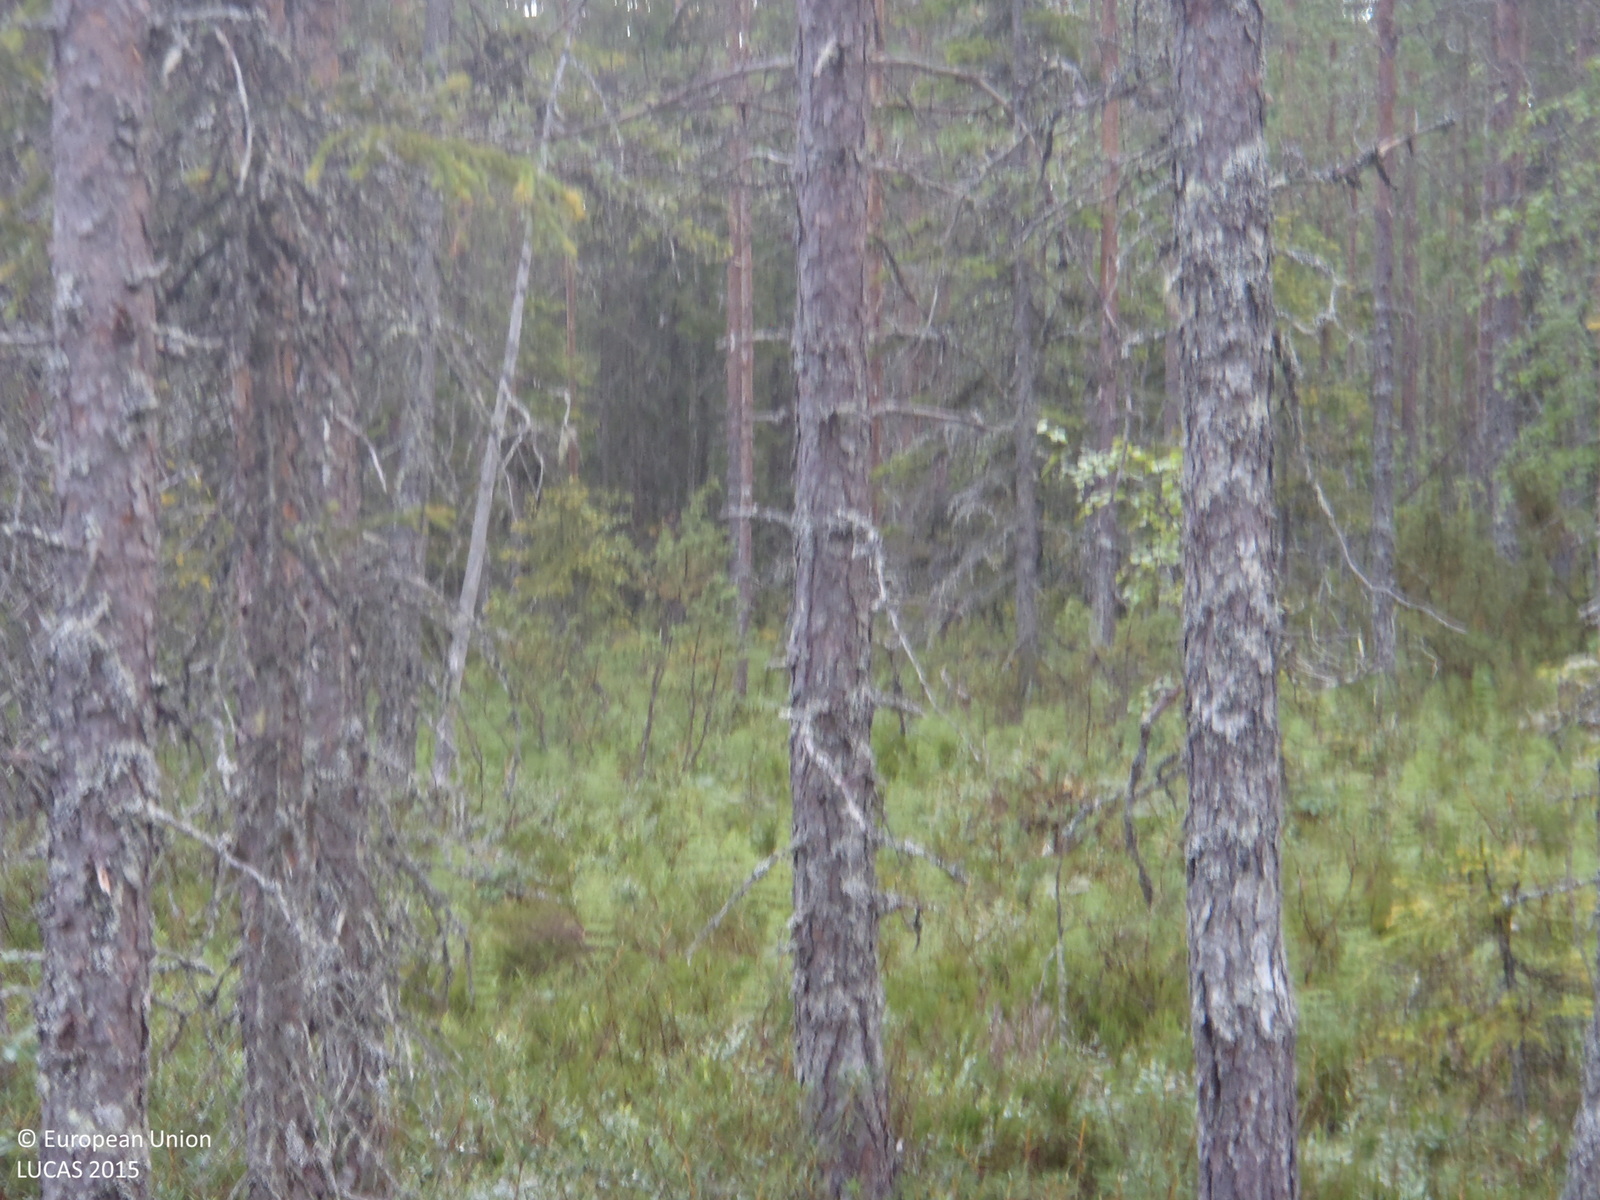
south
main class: Woodland
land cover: Pine dominated mixed woodland
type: mire and swamp forests
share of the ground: > 75 %
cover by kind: coniferous forest trees 55 %, broadleaved forest trees 20 %, shrubs 15 %, herbaceous plants 5 %, lichens and mosses 5 %
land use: Forestry
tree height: > 5 m
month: July
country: FI
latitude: 64.7827
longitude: 27.2337
